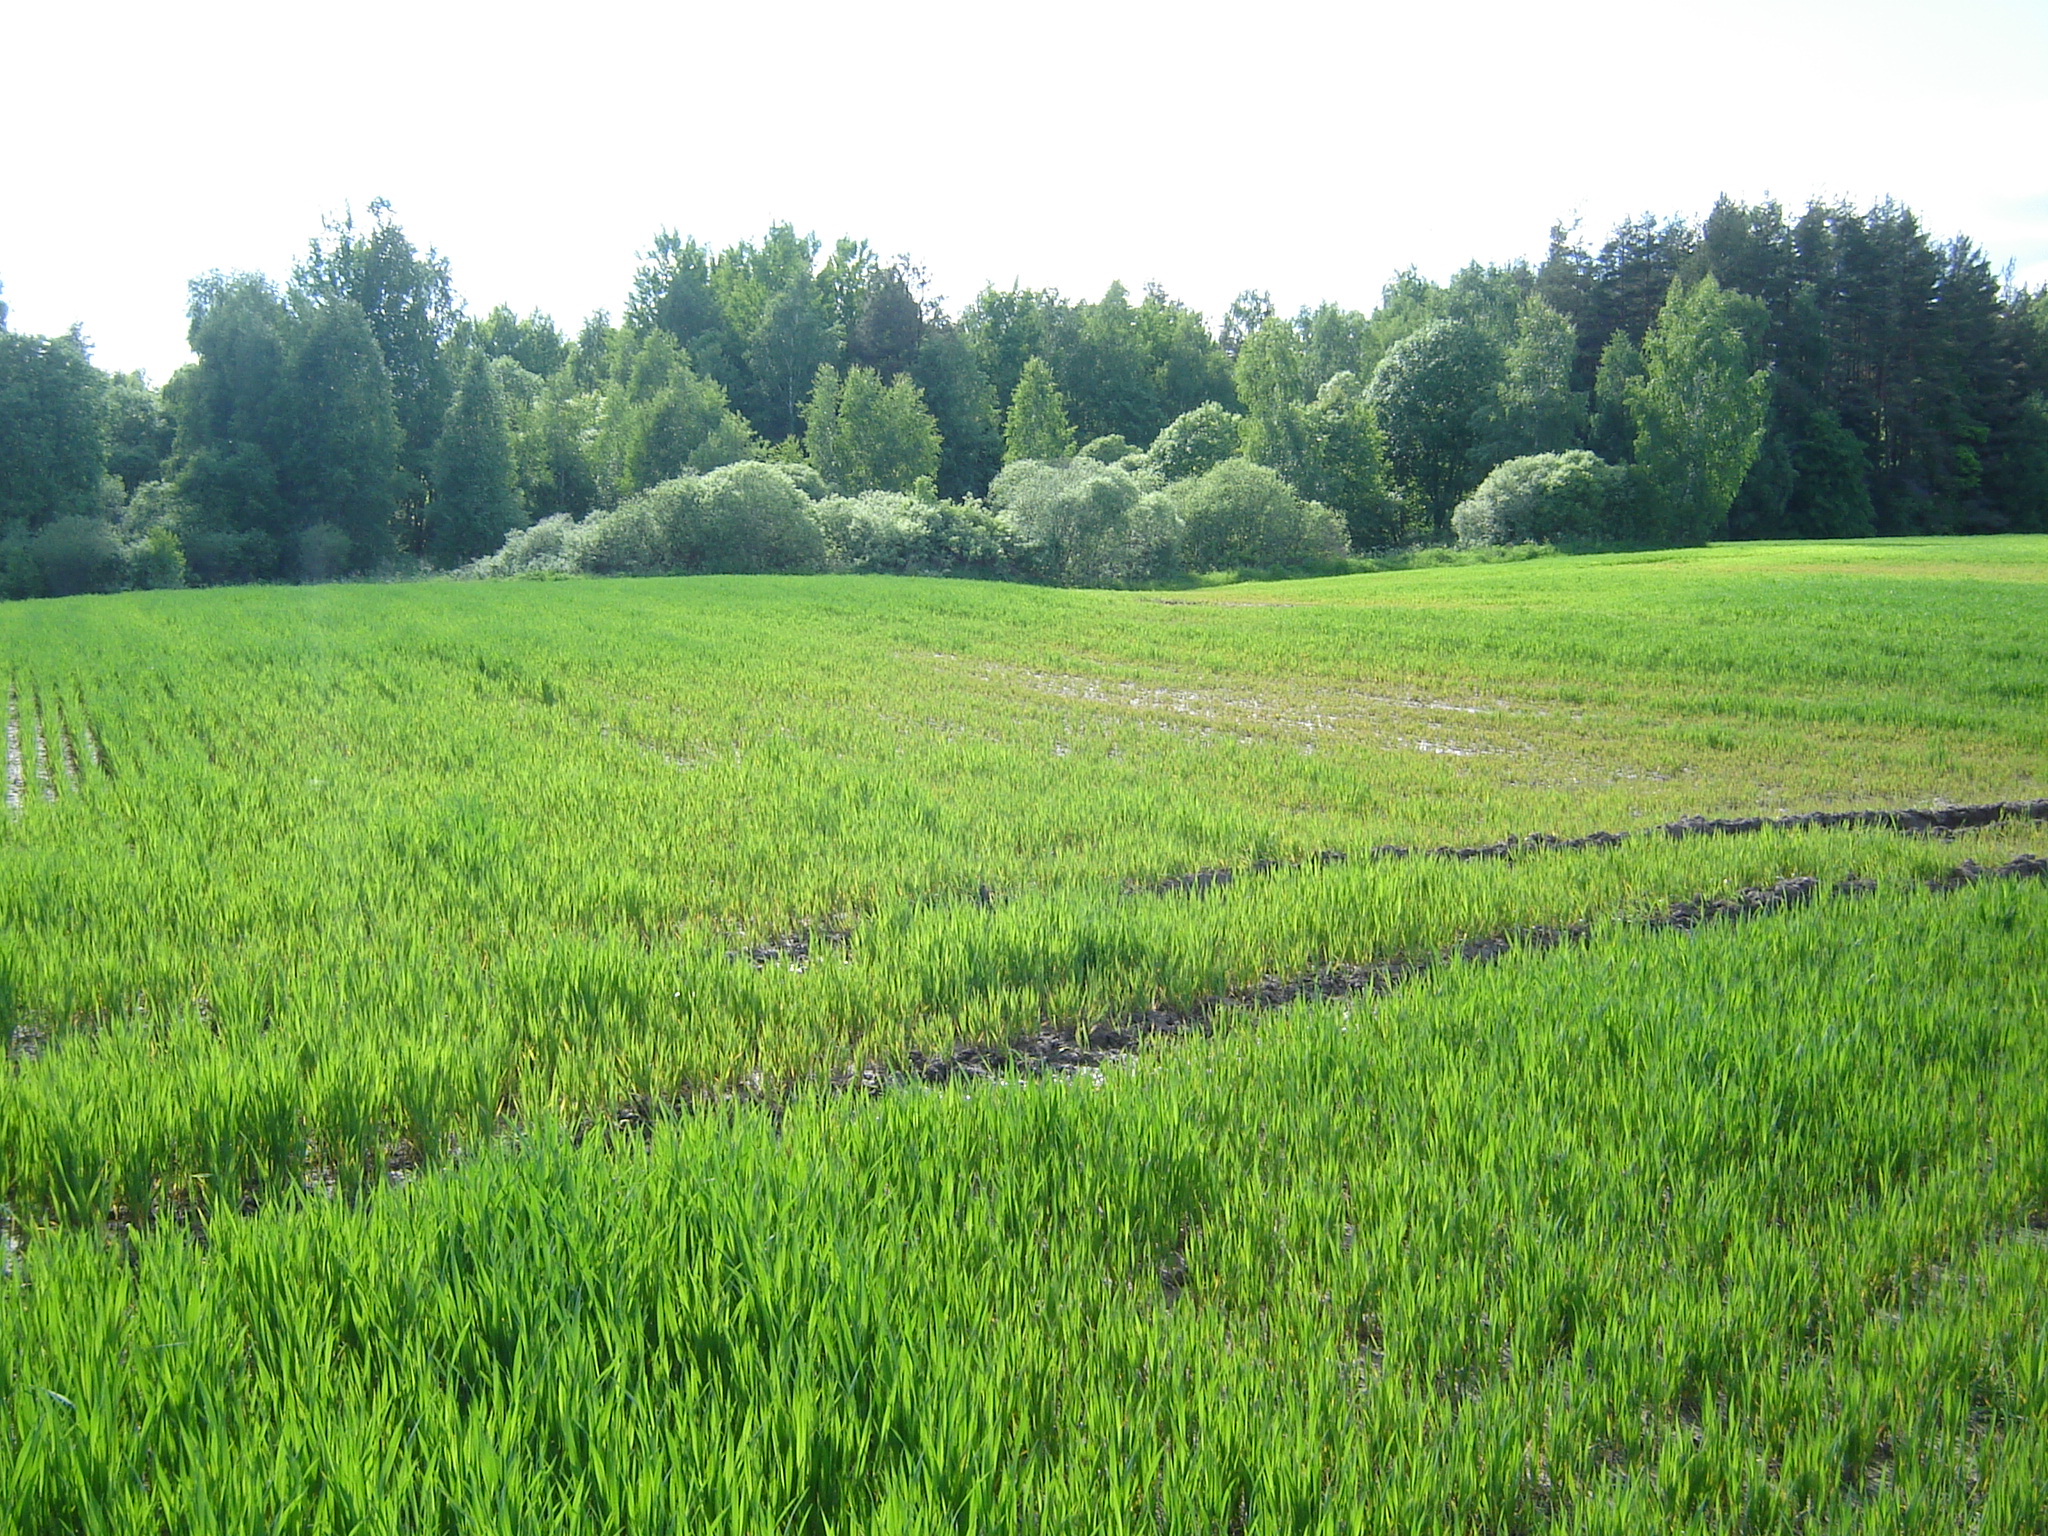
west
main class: Cropland
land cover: Barley
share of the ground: > 75 %
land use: Agriculture (excluding fallow land and kitchen gardens)
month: May
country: LT
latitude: 55.7295
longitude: 25.2280
